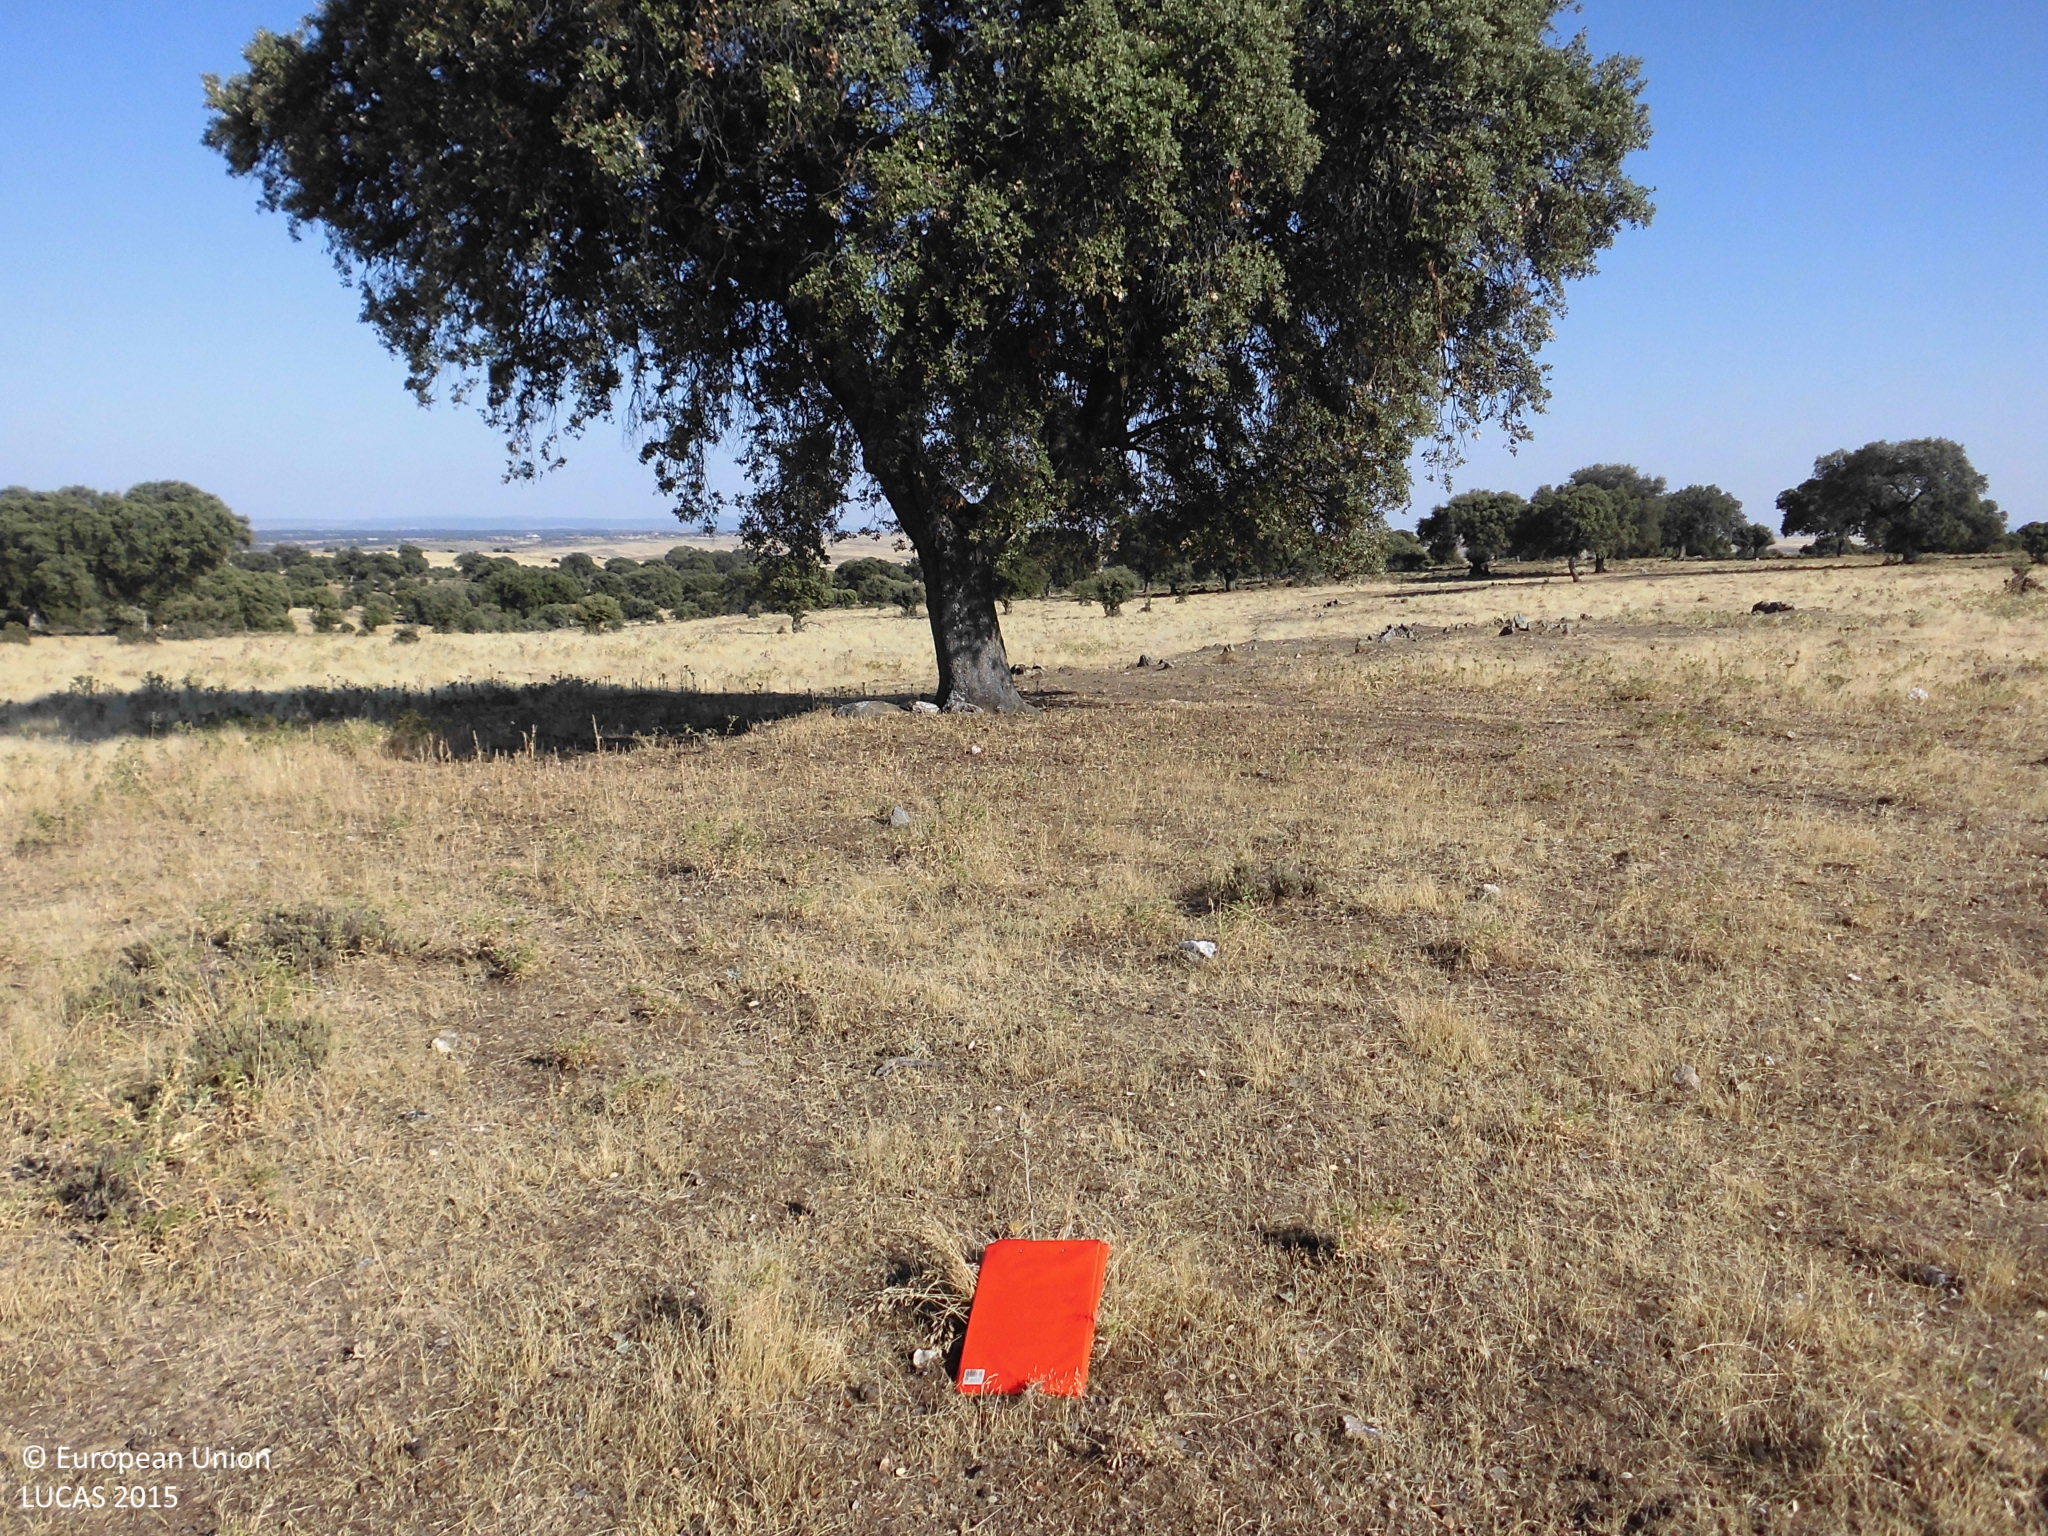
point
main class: Woodland
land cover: Broadleaved woodland
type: broadleaved evergreen forest
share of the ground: 10 - 25 %
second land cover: Grassland without tree/shrub cover
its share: > 75 %
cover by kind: herbaceous plants 90 %, broadleaved forest trees 10 %
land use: Forestry
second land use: Agriculture (excluding fallow land and kitchen gardens)
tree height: > 5 m
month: June
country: ES
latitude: 39.6198
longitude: -6.0344
